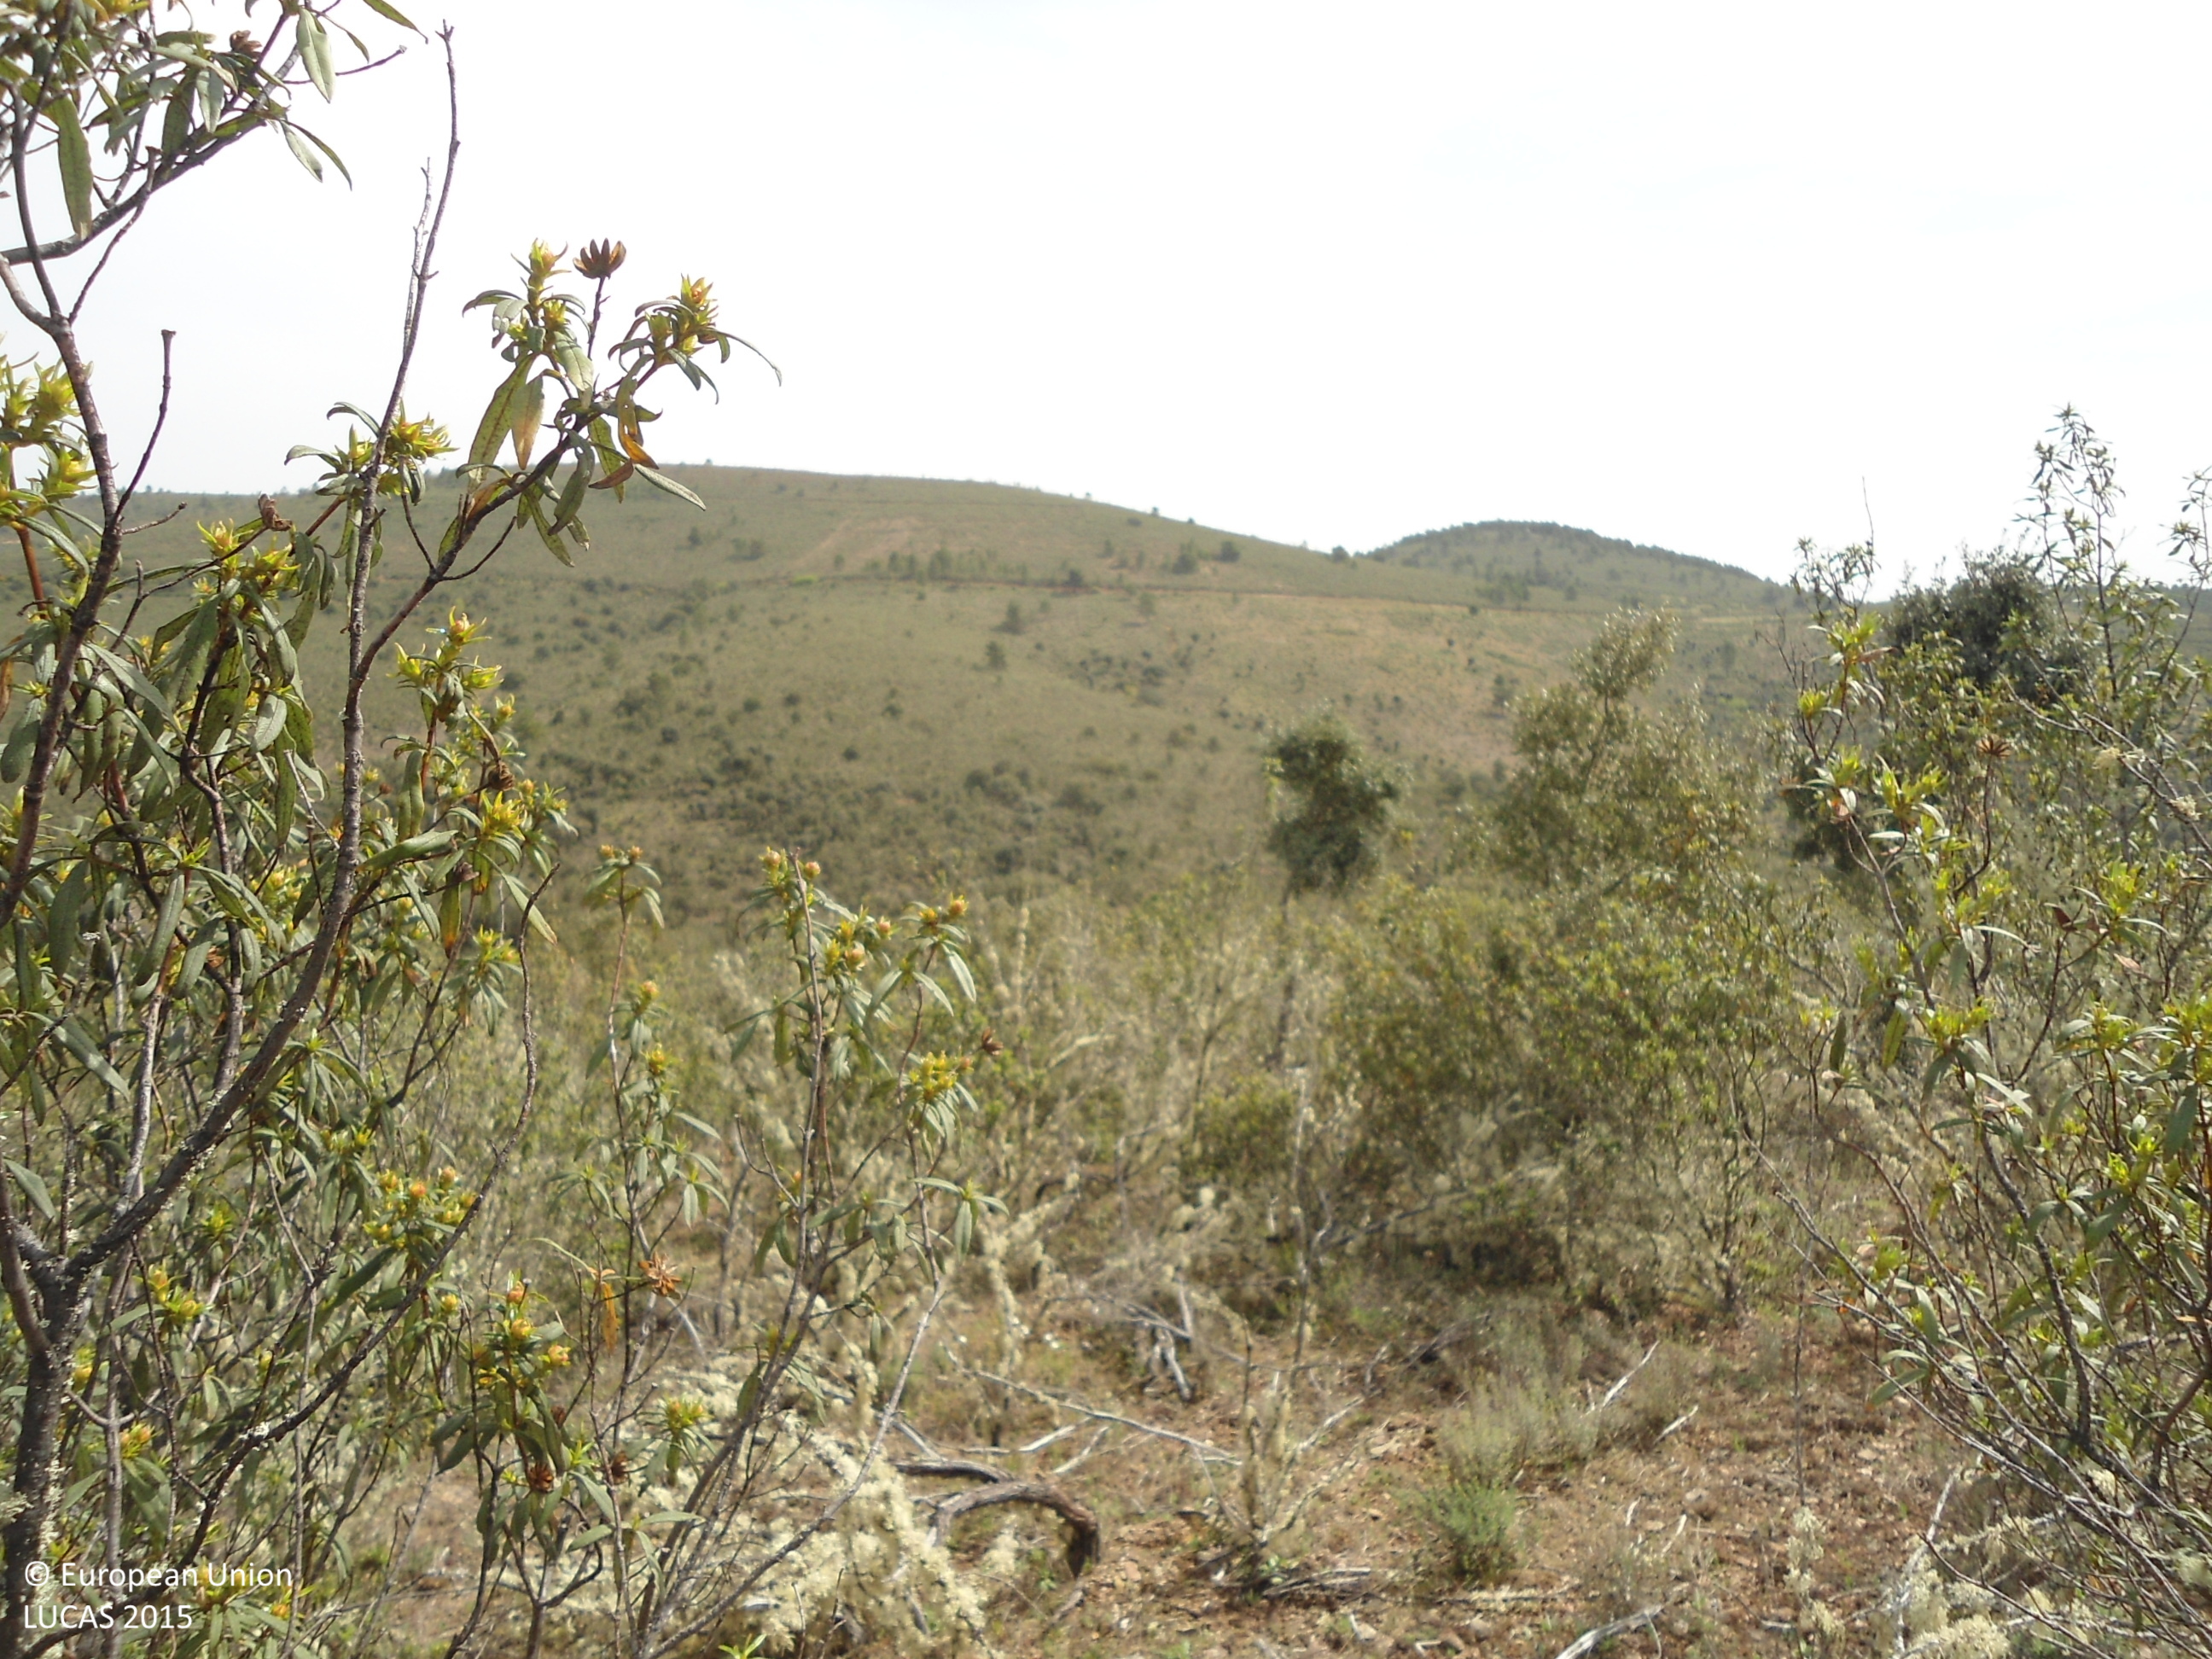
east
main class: Shrubland
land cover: Shrubland with sparse tree cover
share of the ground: > 75 %
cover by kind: shrubs 95 %, coniferous forest trees 5 %
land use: Forestry
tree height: < 5 m
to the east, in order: Shrubland with sparse tree cover; Pine dominated mixed woodland; Tracks; Broadleaved woodland; Rivers and streams; Grassland with sparse tree/shrub cover; Abandoned hedges; Rivers and streams; Dry stone walls; Abandoned hedges; Grassland with sparse tree/shrub cover; Abandoned hedges; Dry stone walls; Grassland with sparse tree/shrub cover; Tracks; Shrubland without tree cover
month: April
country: ES
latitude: 41.8244
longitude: -6.4933
